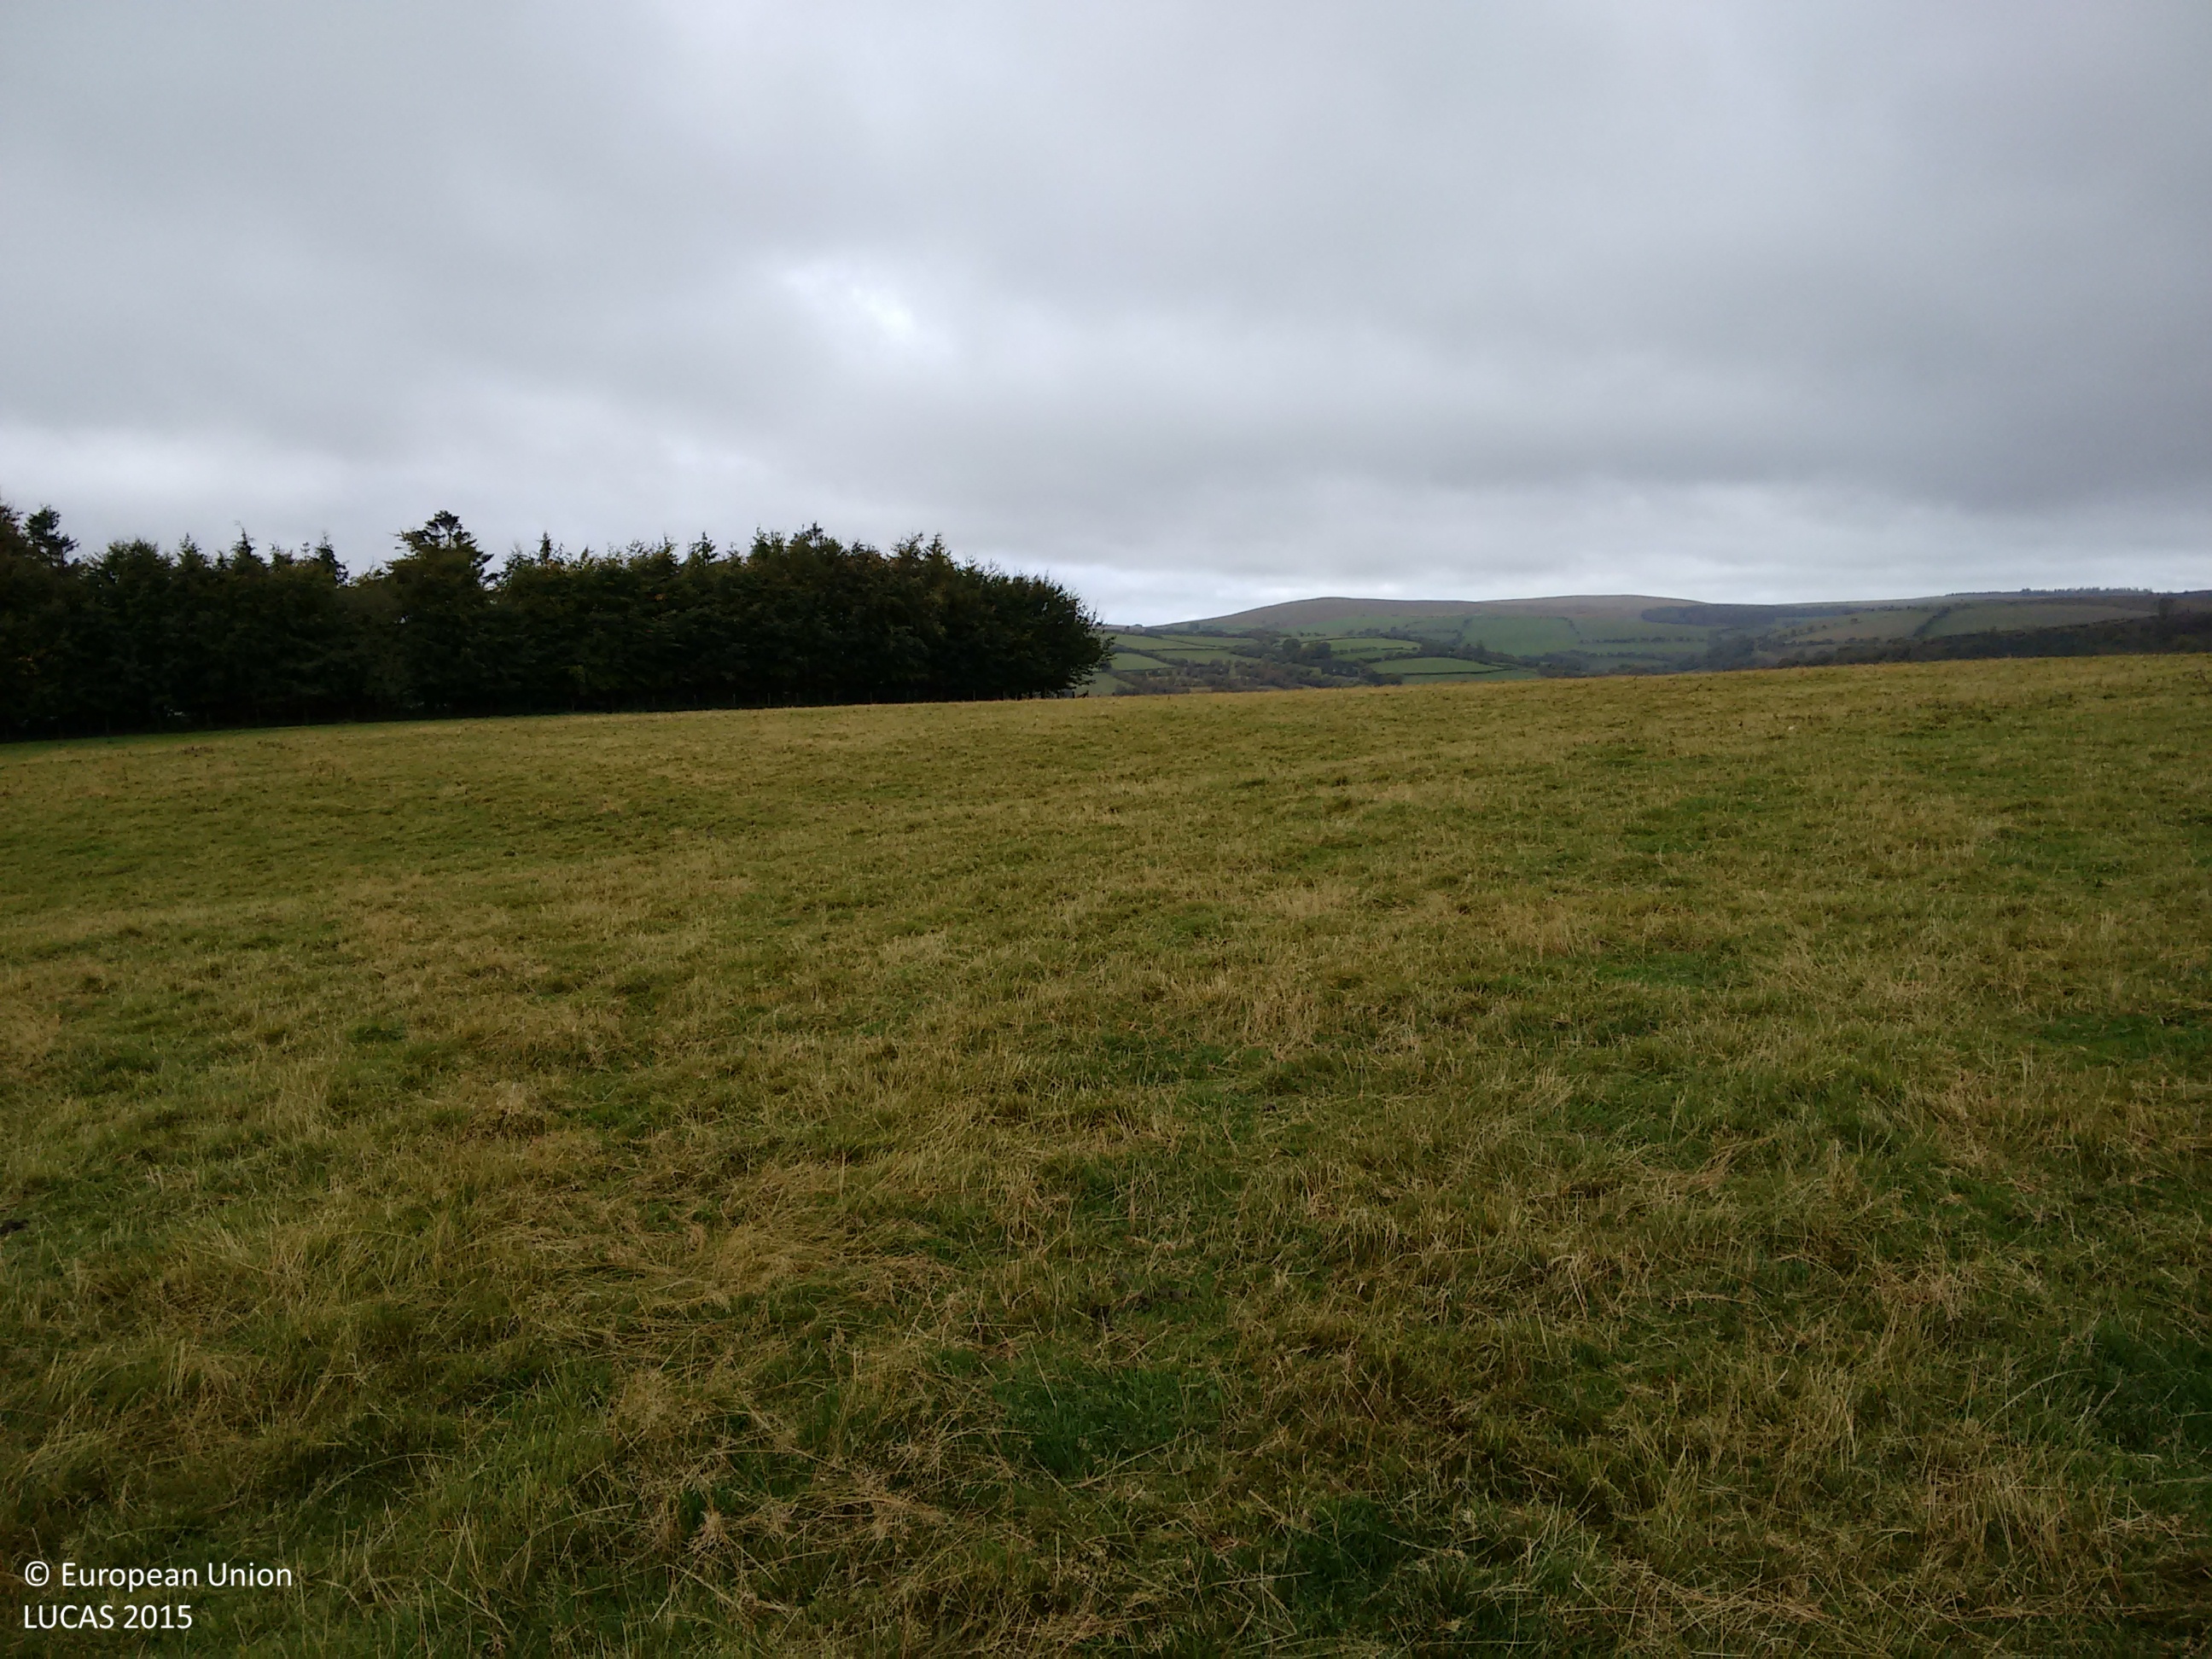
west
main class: Grassland
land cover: Grassland without tree/shrub cover
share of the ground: > 75 %
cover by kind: herbaceous plants 100 %
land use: Agriculture (excluding fallow land and kitchen gardens)
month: October
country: GB
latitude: 52.4365
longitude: -3.2146
